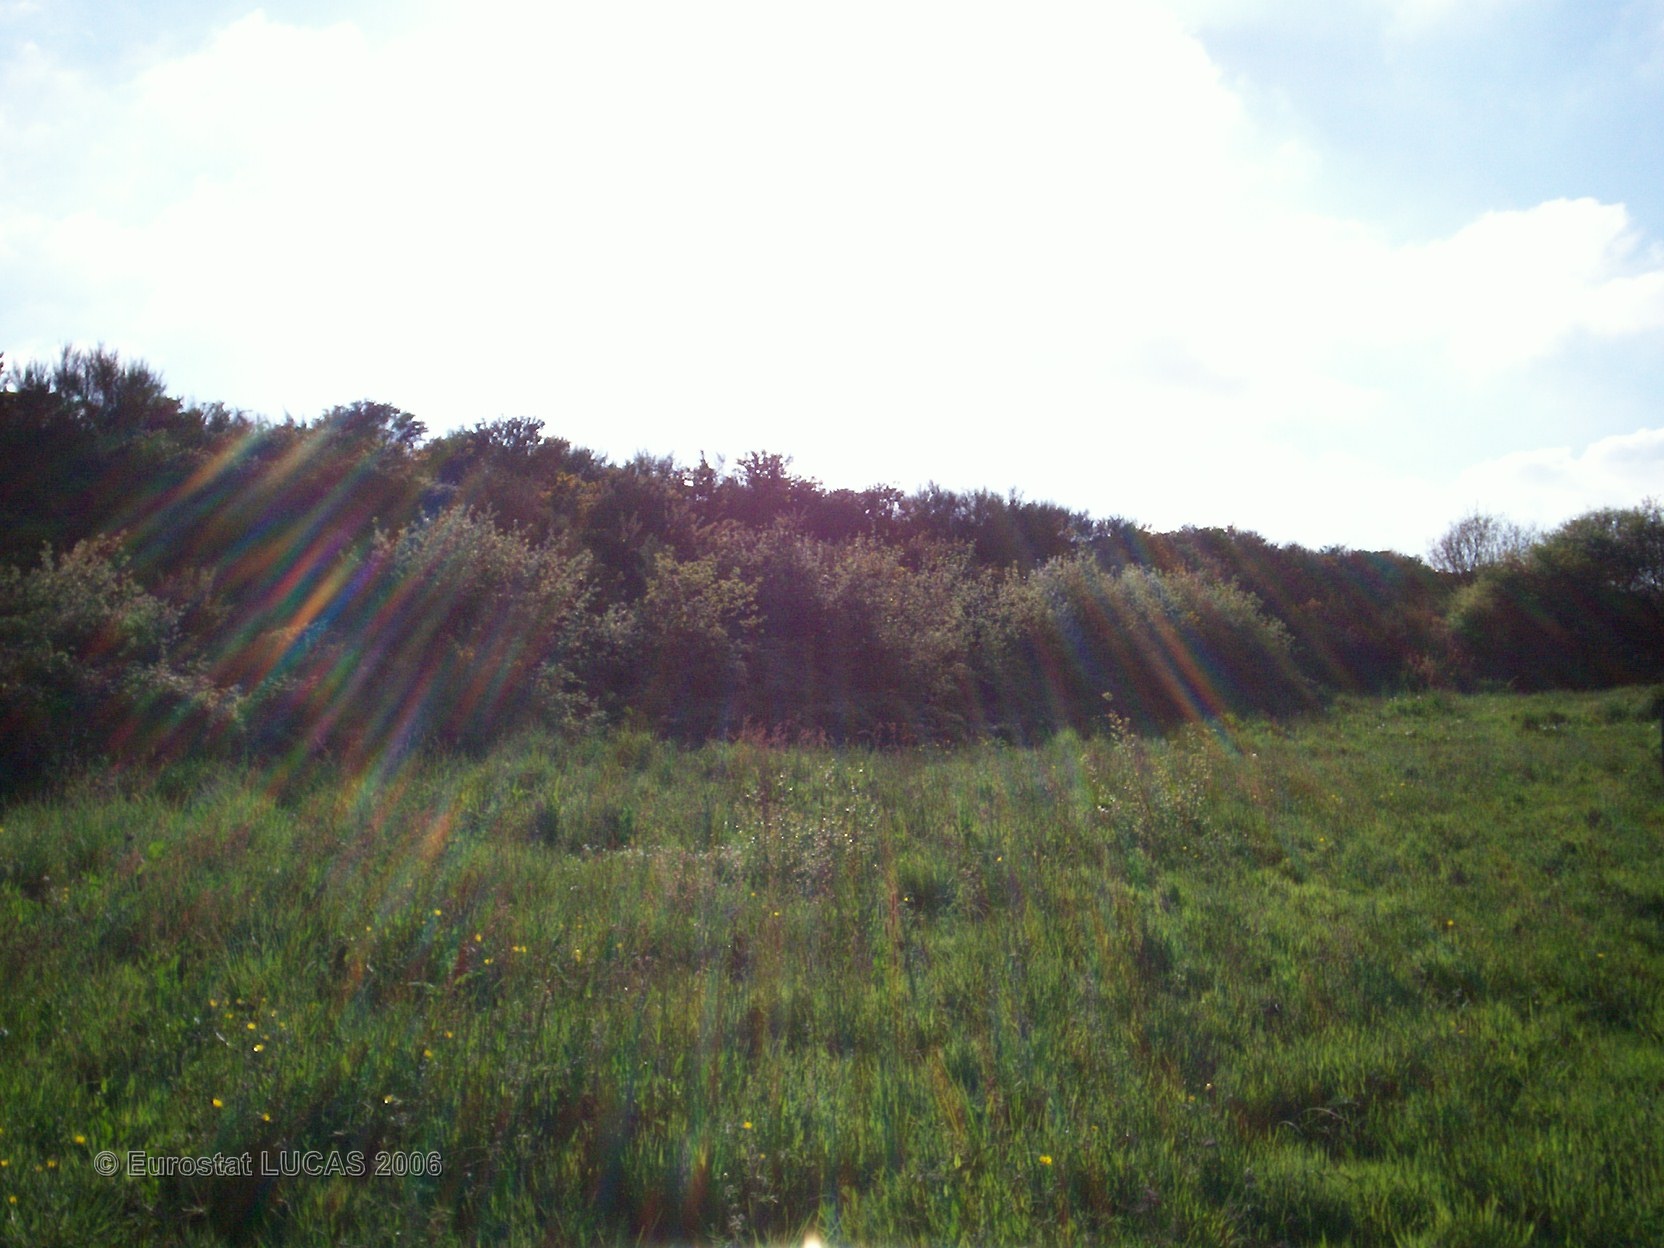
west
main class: Grassland
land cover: Grassland without tree/shrub cover
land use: Agriculture (excluding fallow land and kitchen gardens)
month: May
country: FR
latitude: 47.6061
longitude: -2.6029
